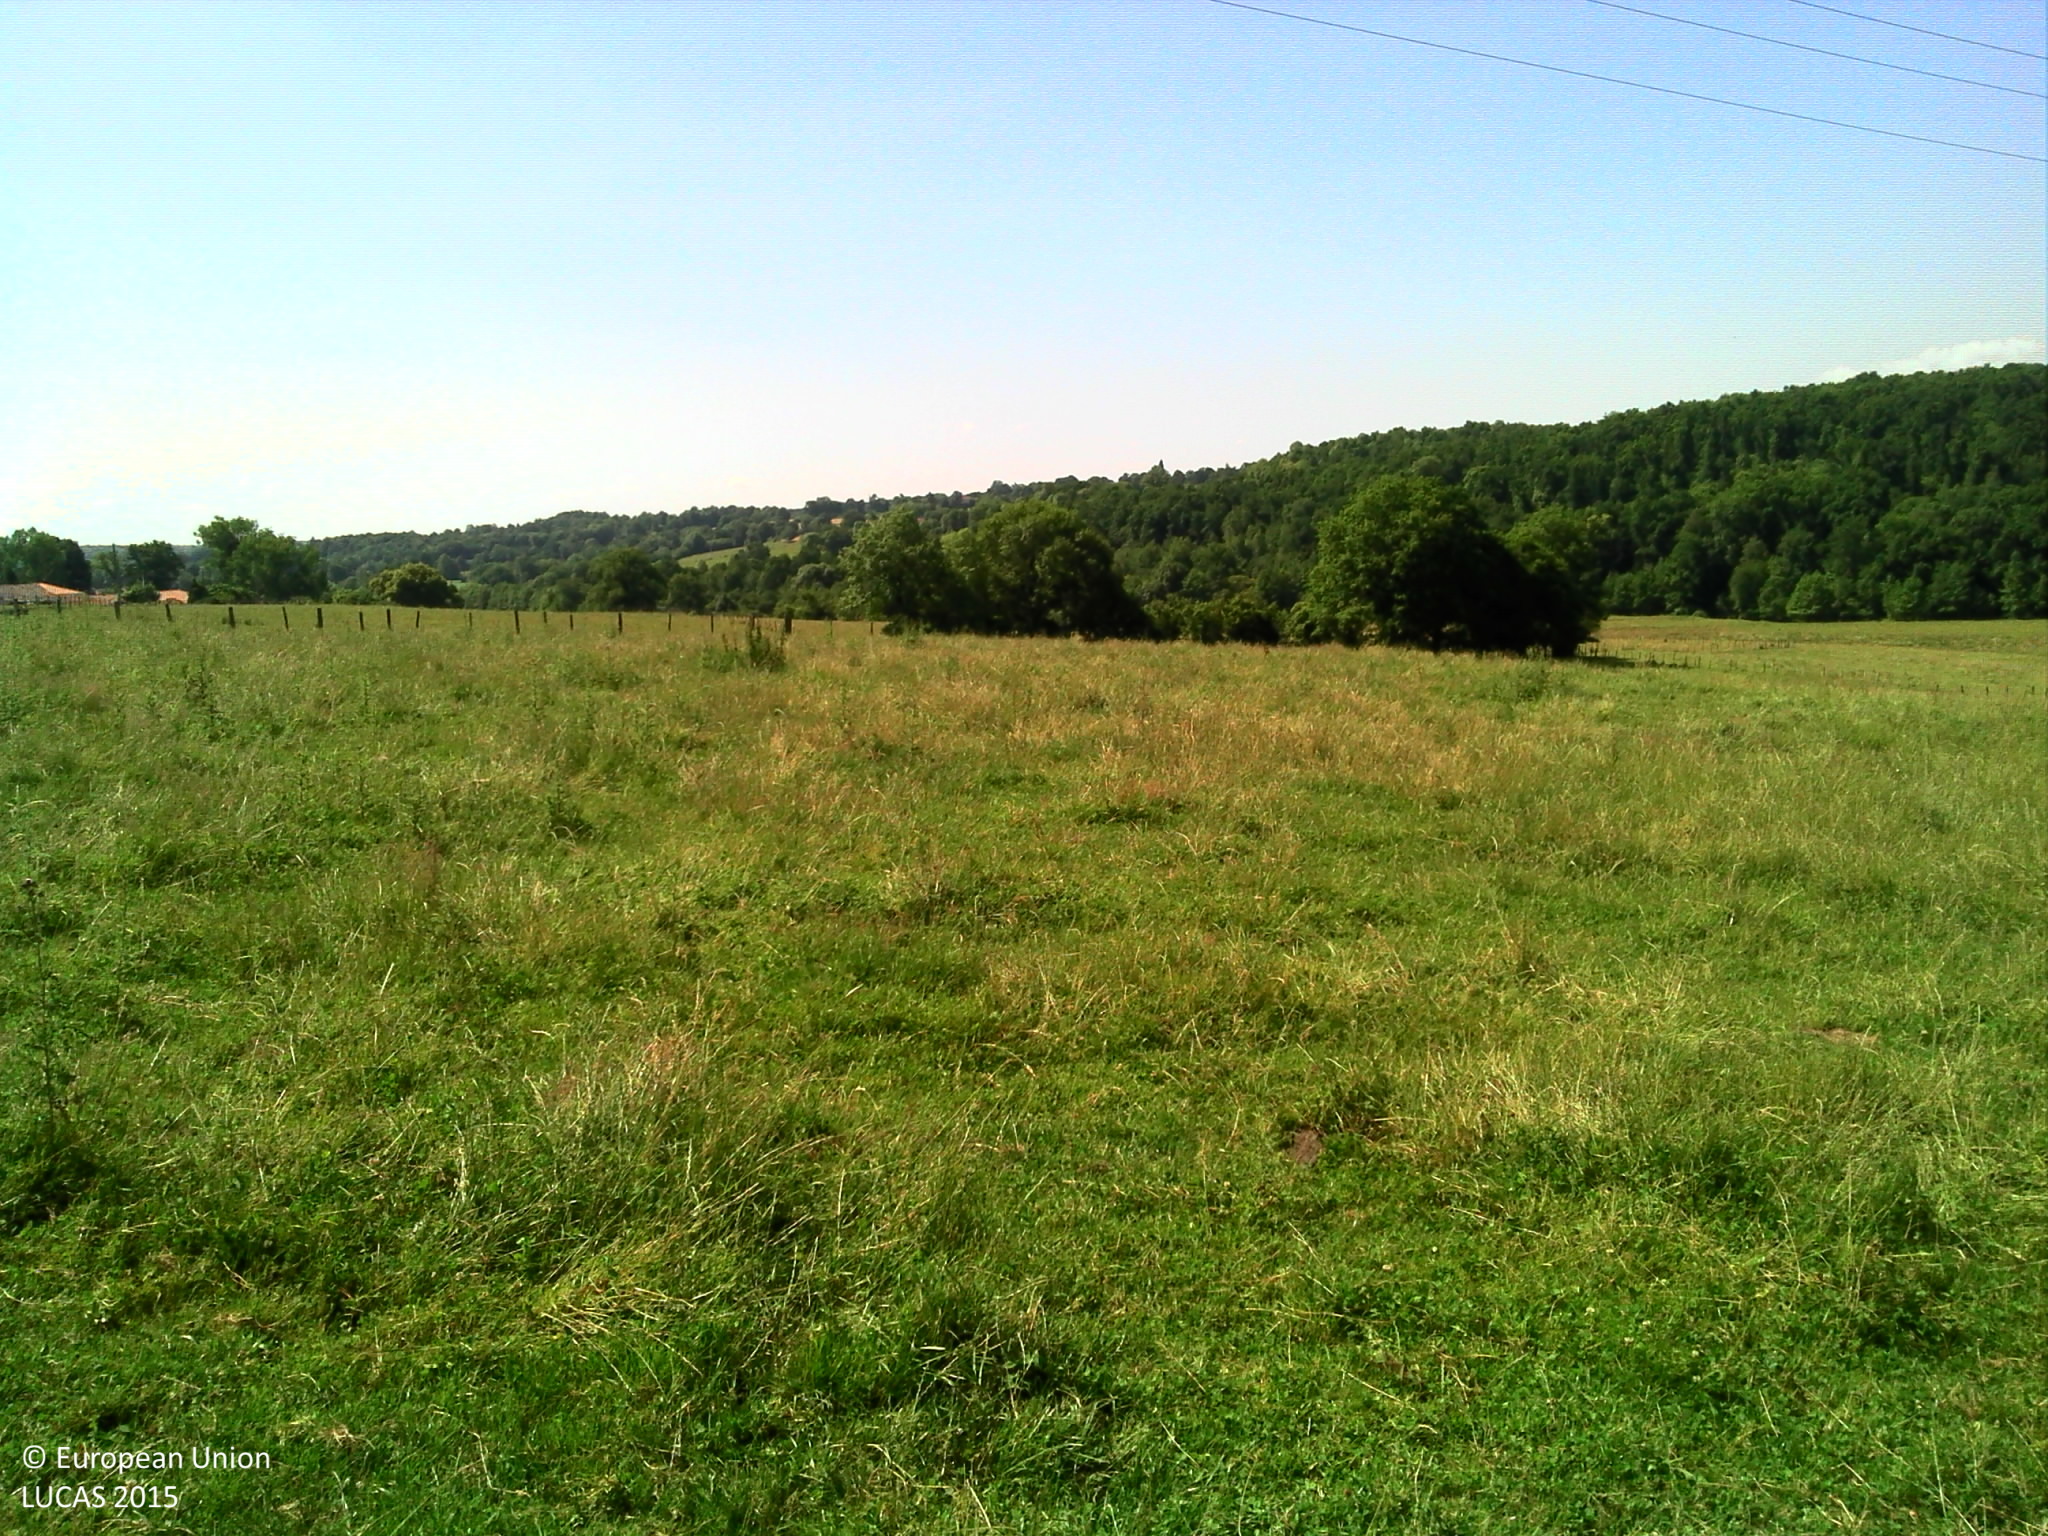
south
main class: Grassland
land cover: Grassland without tree/shrub cover
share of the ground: > 75 %
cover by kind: herbaceous plants 100 %
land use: Agriculture (excluding fallow land and kitchen gardens)
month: June
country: FR
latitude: 45.8658
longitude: 0.6215
